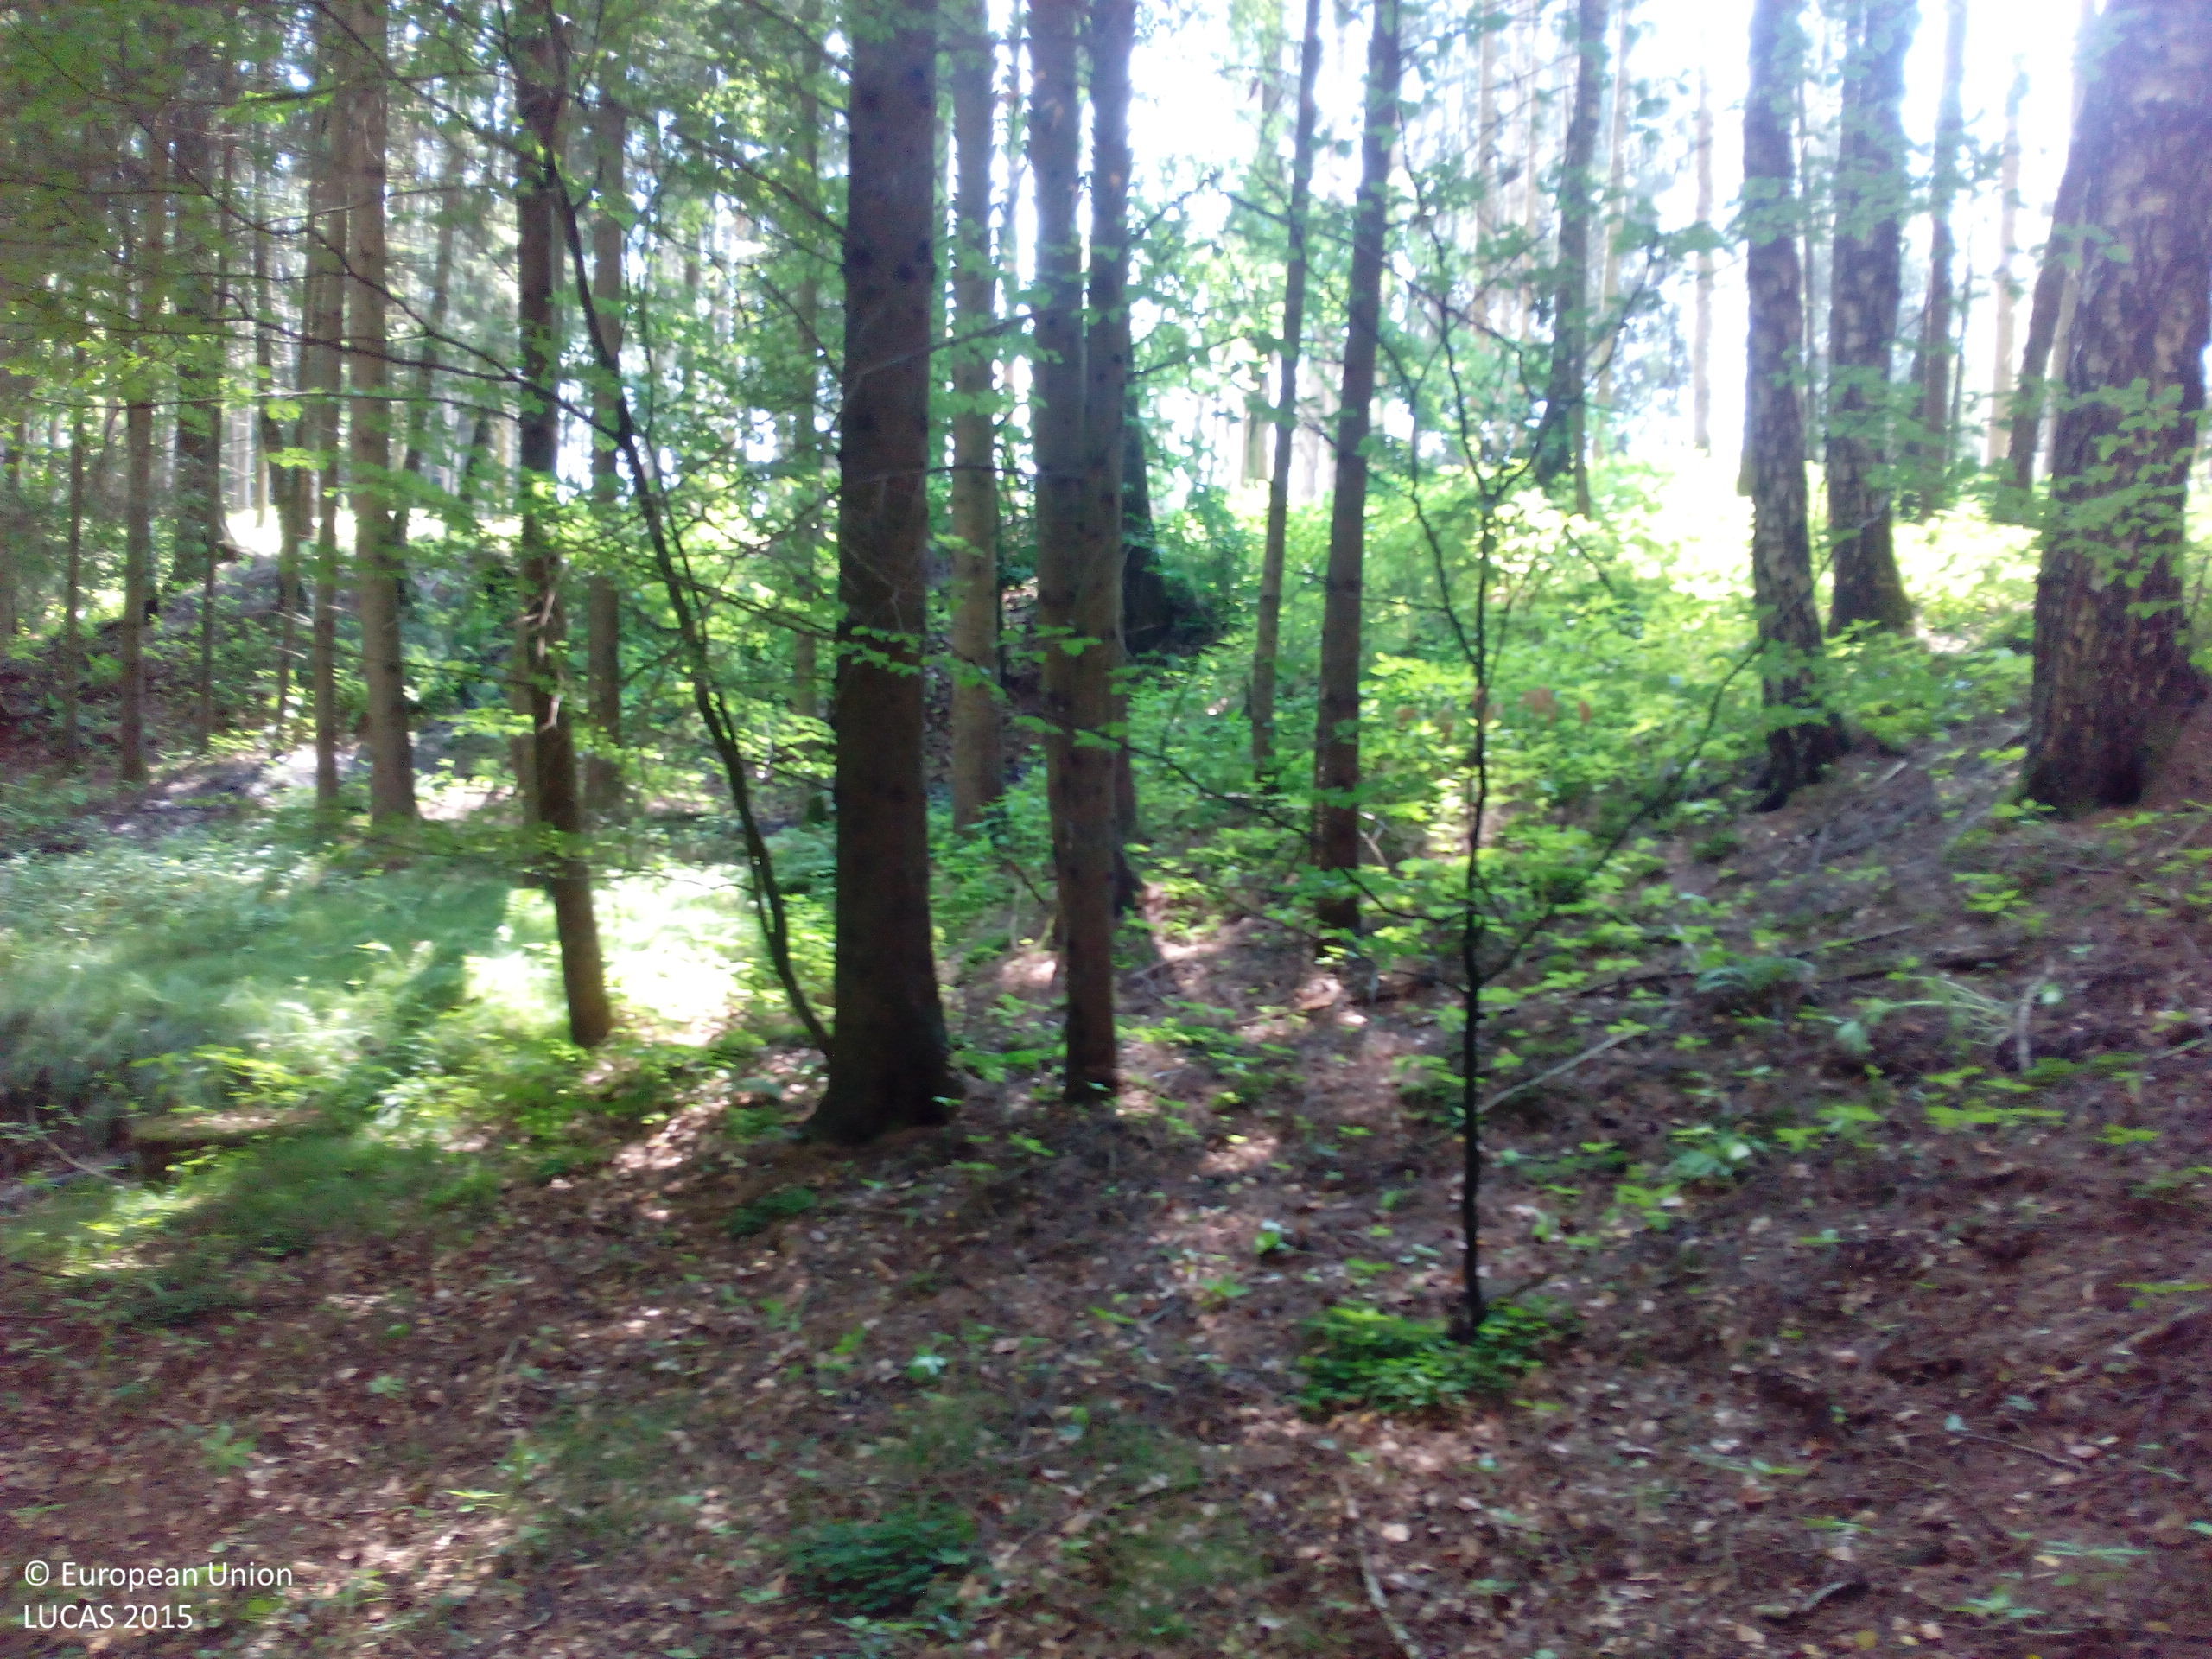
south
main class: Woodland
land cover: Spruce dominated mixed woodland
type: hemiboreal forest and nemoral coniferous forest and mixed broadleaved-coniferous forest
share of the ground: > 75 %
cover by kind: broadleaved forest trees 60 %, coniferous forest trees 25 %, unconsolidated bare surface 10 %, herbaceous plants 5 %
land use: Forestry
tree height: > 5 m
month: June
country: DE
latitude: 48.5086
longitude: 12.9366
